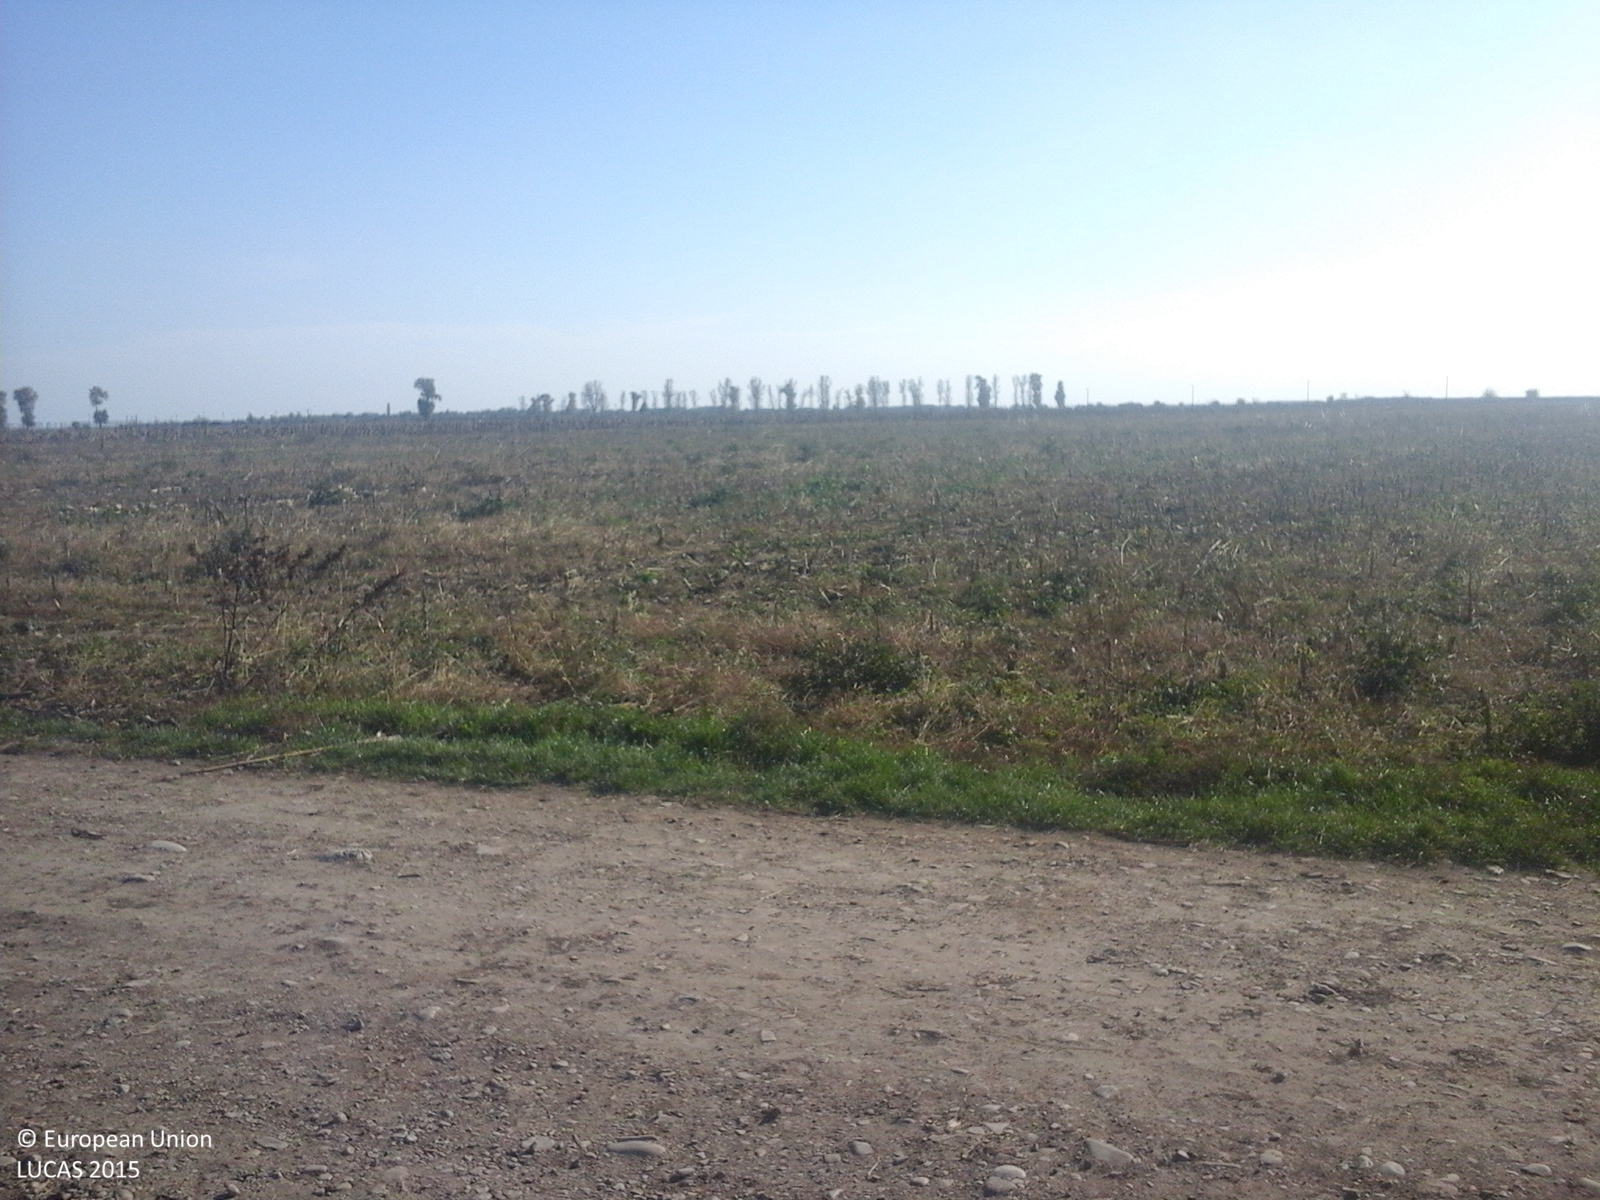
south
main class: Grassland
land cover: Spontaneously vegetated surfaces
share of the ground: > 75 %
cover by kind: herbaceous plants 100 %
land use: Fallow land
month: October
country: RO
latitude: 45.2489
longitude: 27.3602
